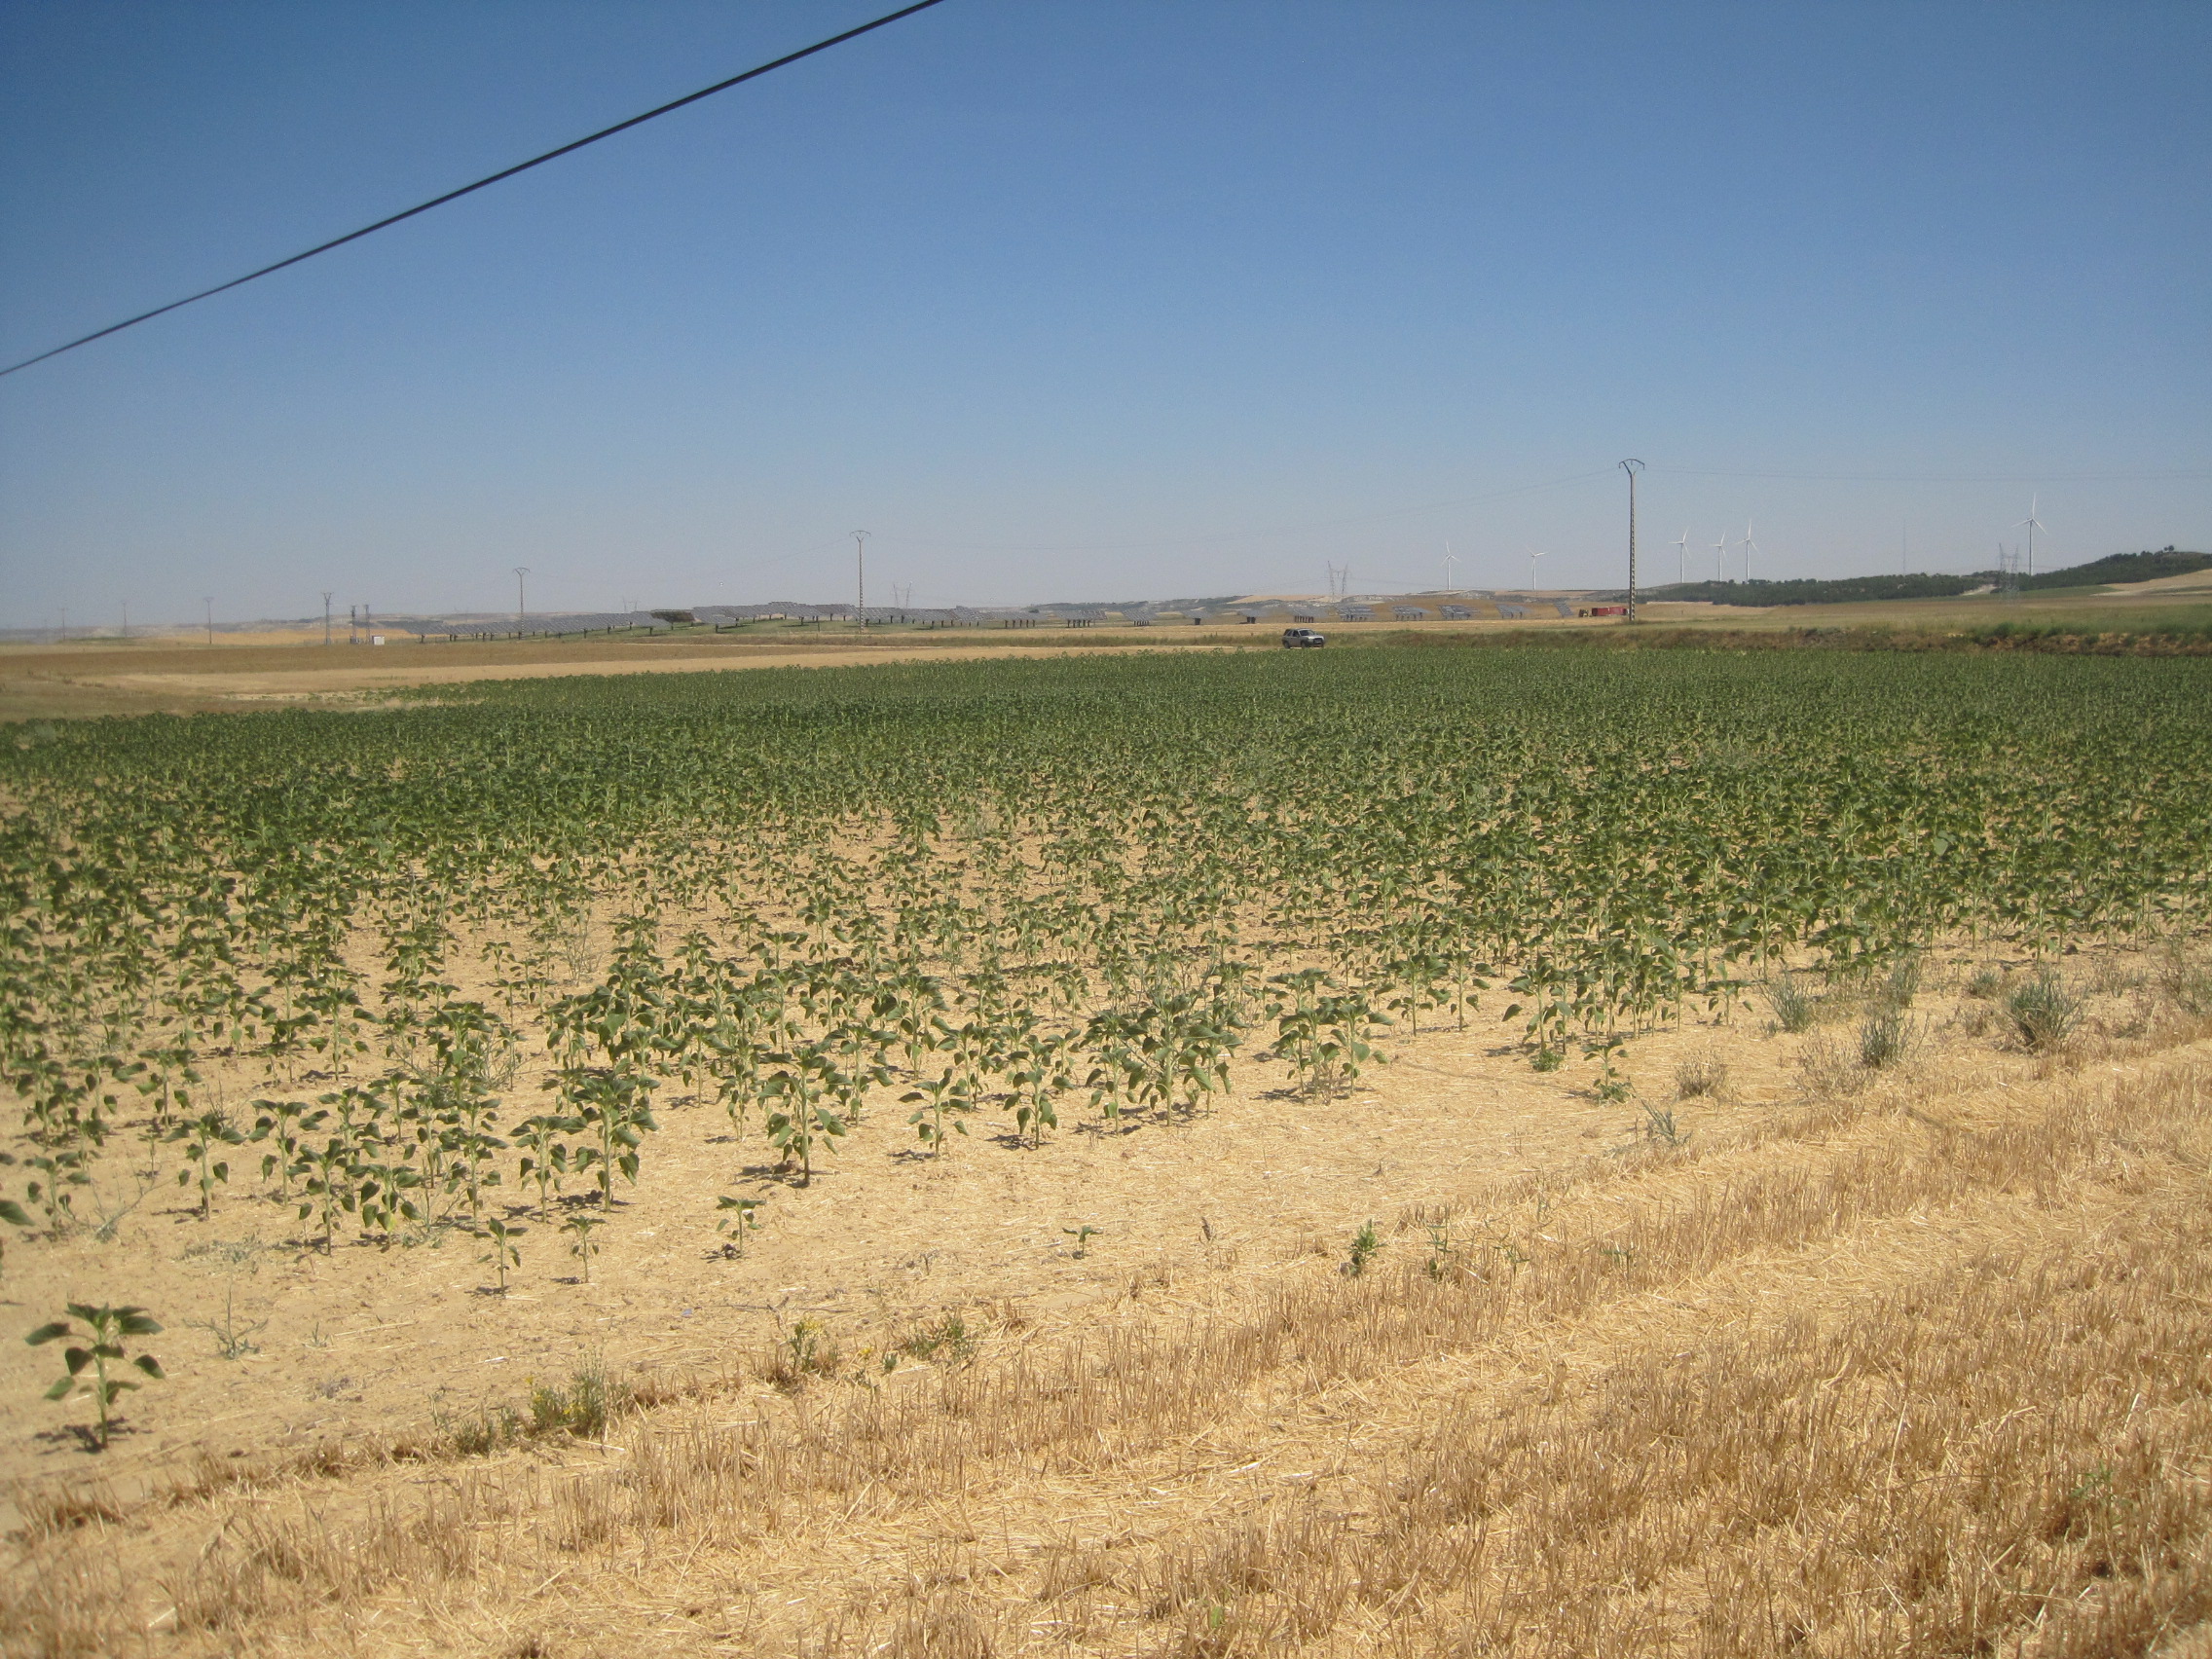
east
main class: Cropland
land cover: Barley
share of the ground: < 10 %
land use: Agriculture (excluding fallow land and kitchen gardens)
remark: Harvested field
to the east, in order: Barley; Sunflower; Electric lines; Sunflower; Barley; Other bare soil; Tracks; Grass margins; Barley
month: July
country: ES
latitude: 41.9692
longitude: -4.7592
